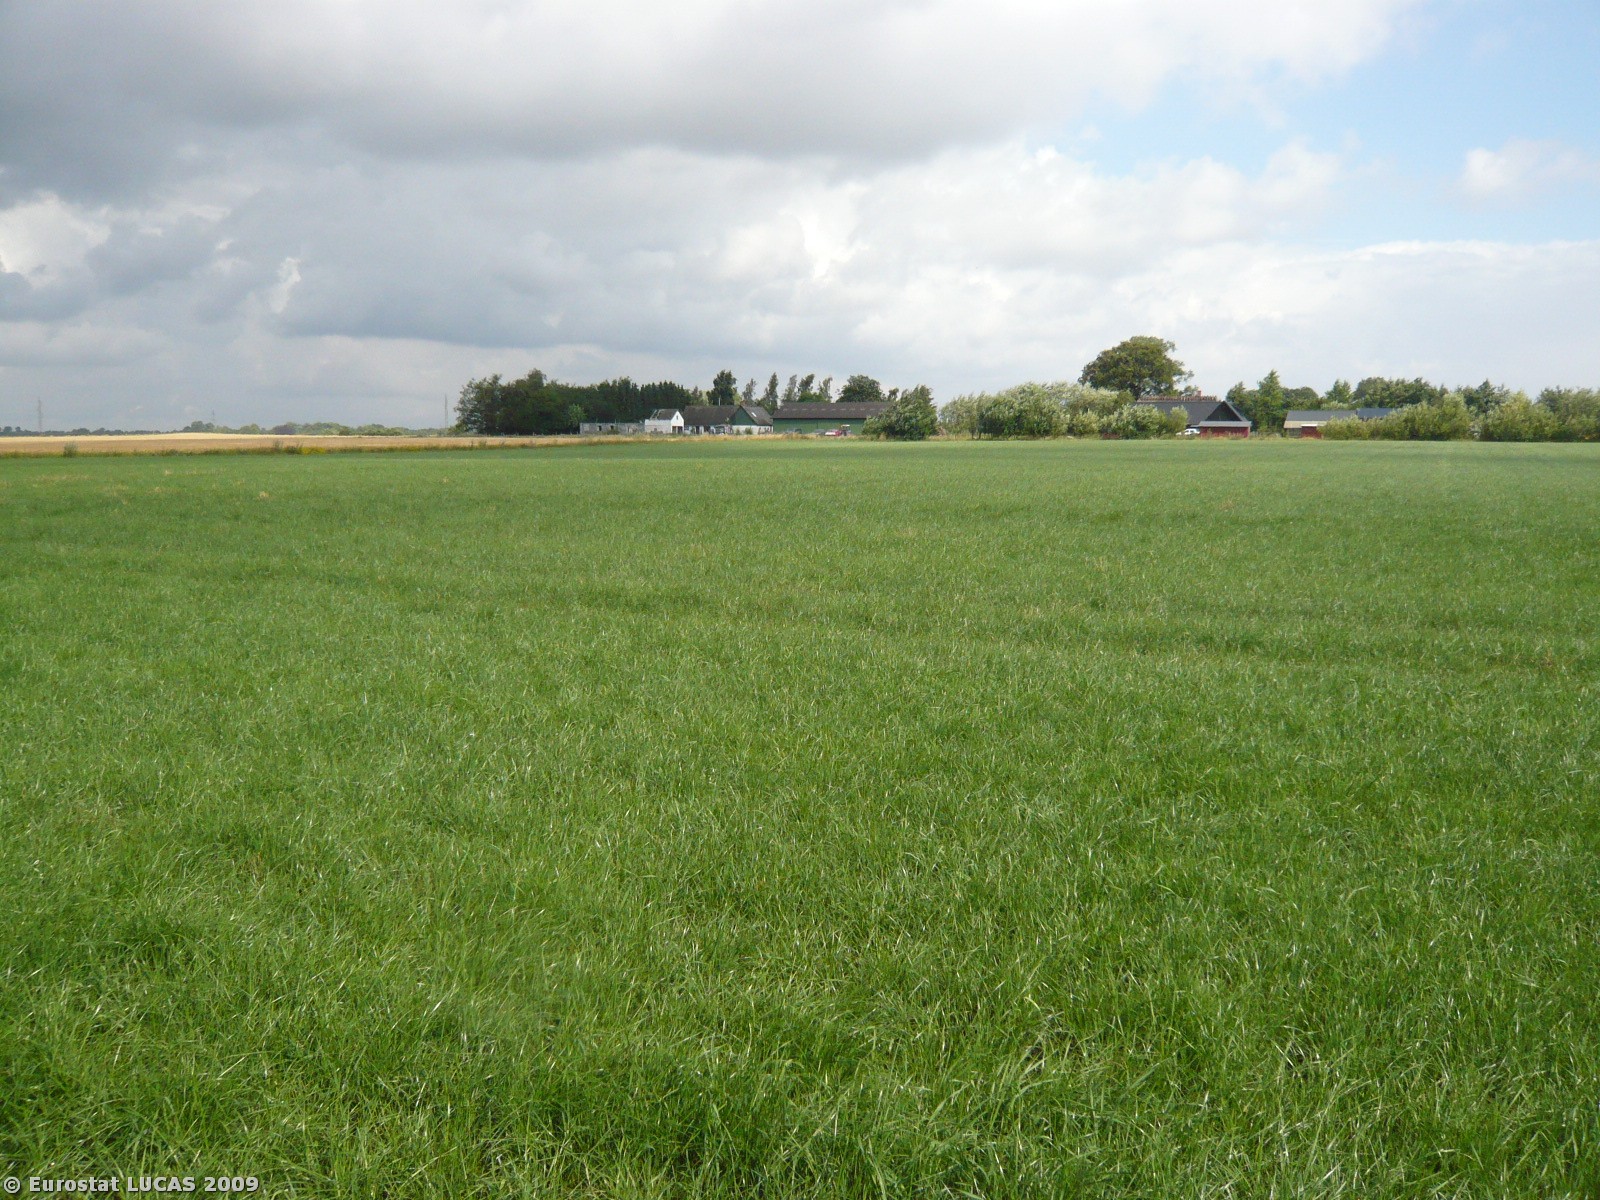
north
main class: Grassland
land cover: Grassland without tree/shrub cover
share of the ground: > 75 %
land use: Agriculture (excluding fallow land and kitchen gardens)
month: July
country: DK
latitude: 55.5956
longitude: 12.0771
